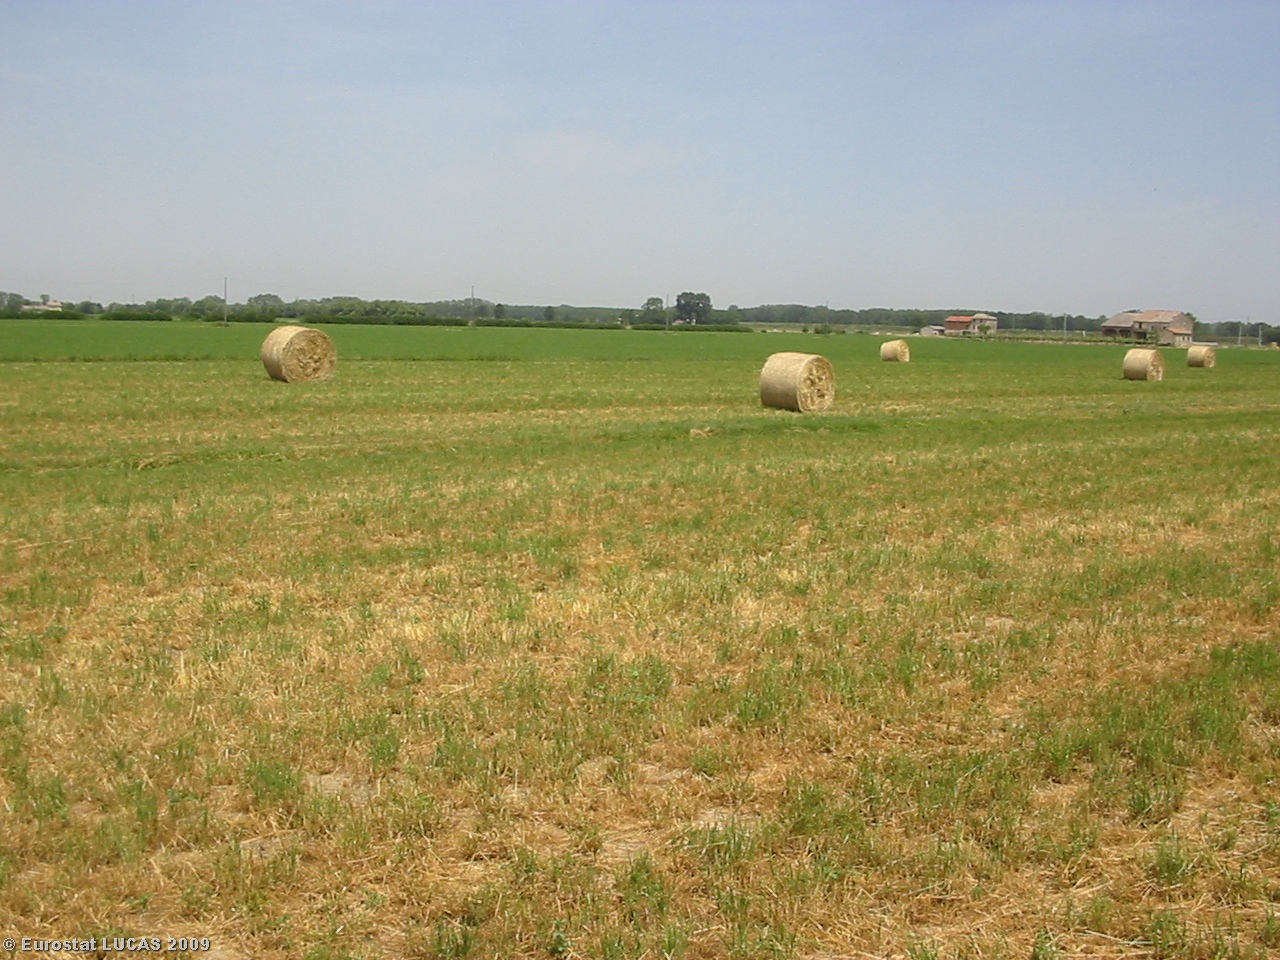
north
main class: Cropland
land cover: Lucerne
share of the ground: < 10 %
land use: Agriculture (excluding fallow land and kitchen gardens)
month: May
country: IT
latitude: 44.9451
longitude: 10.3415
